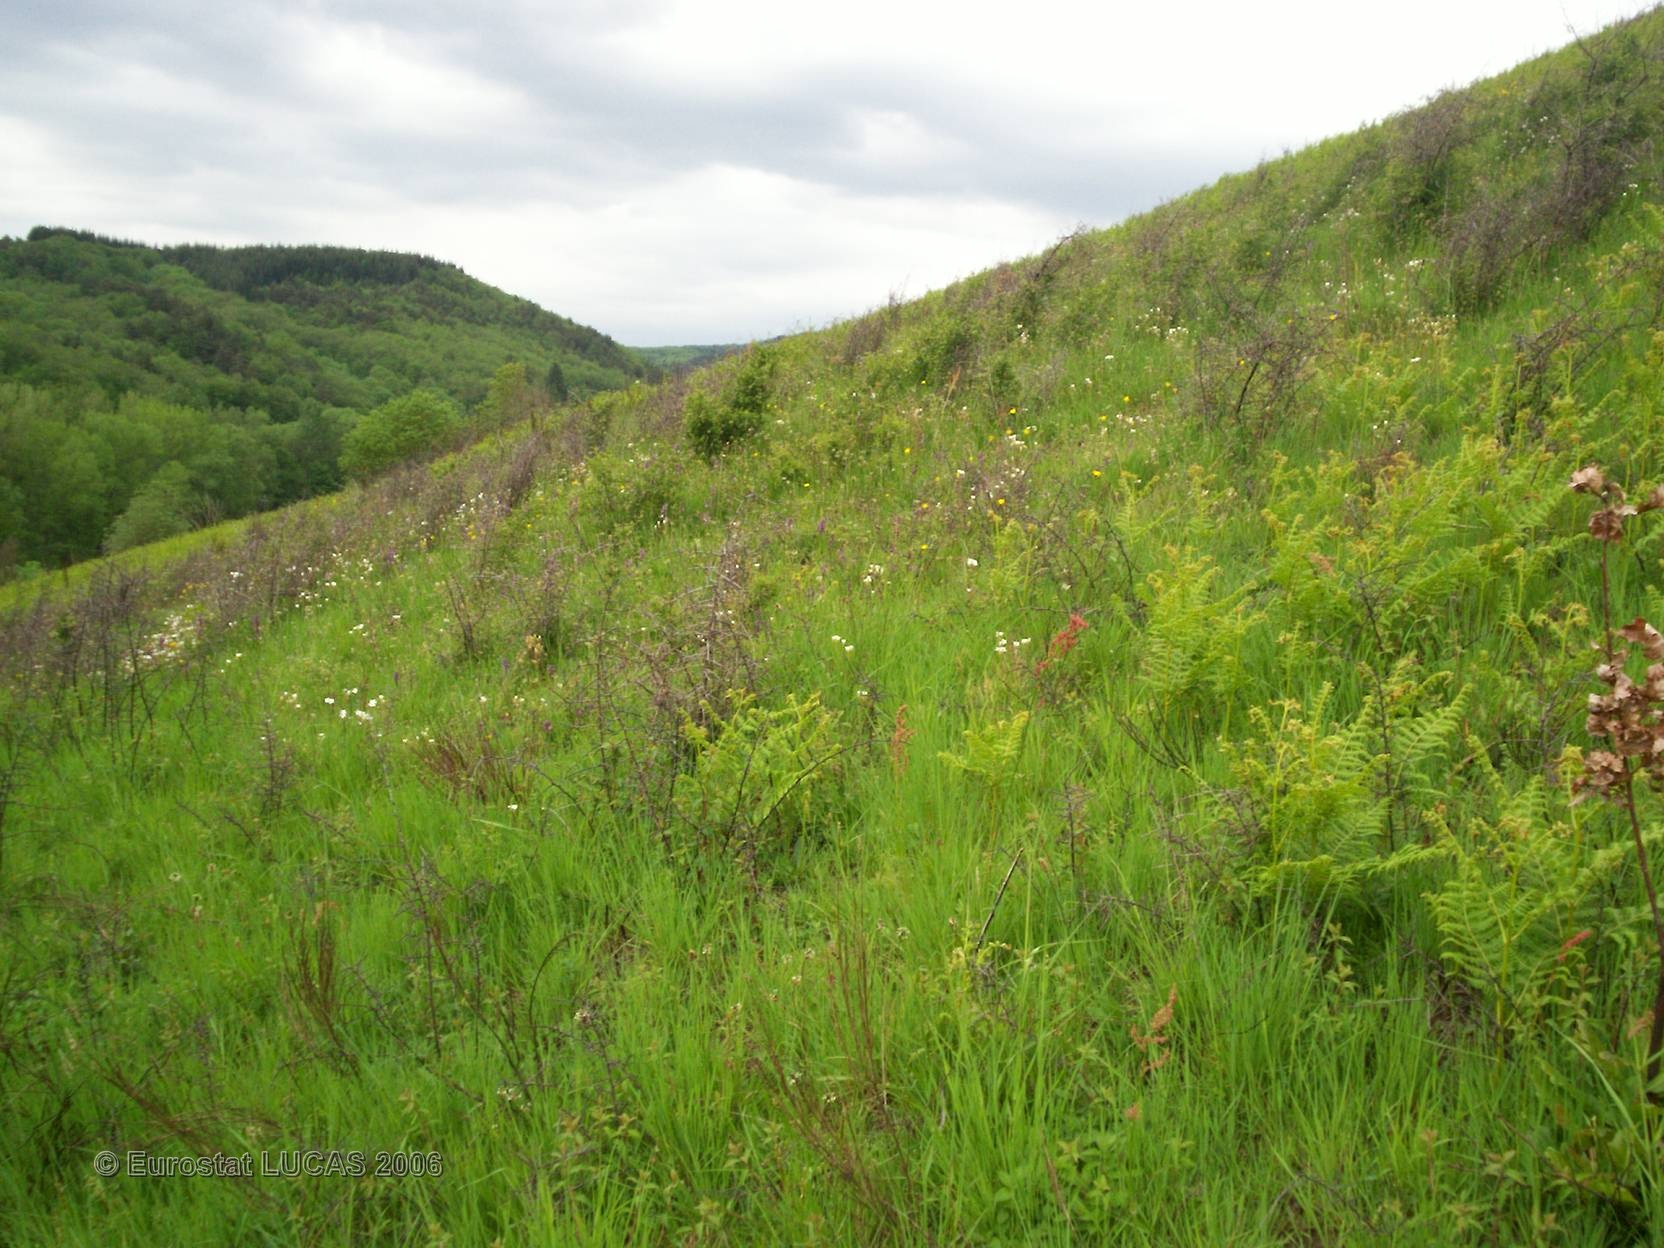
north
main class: Grassland
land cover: Grassland with sparse tree/shrub cover
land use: Agriculture (excluding fallow land and kitchen gardens)
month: May
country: FR
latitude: 43.9767
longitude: 3.3876
